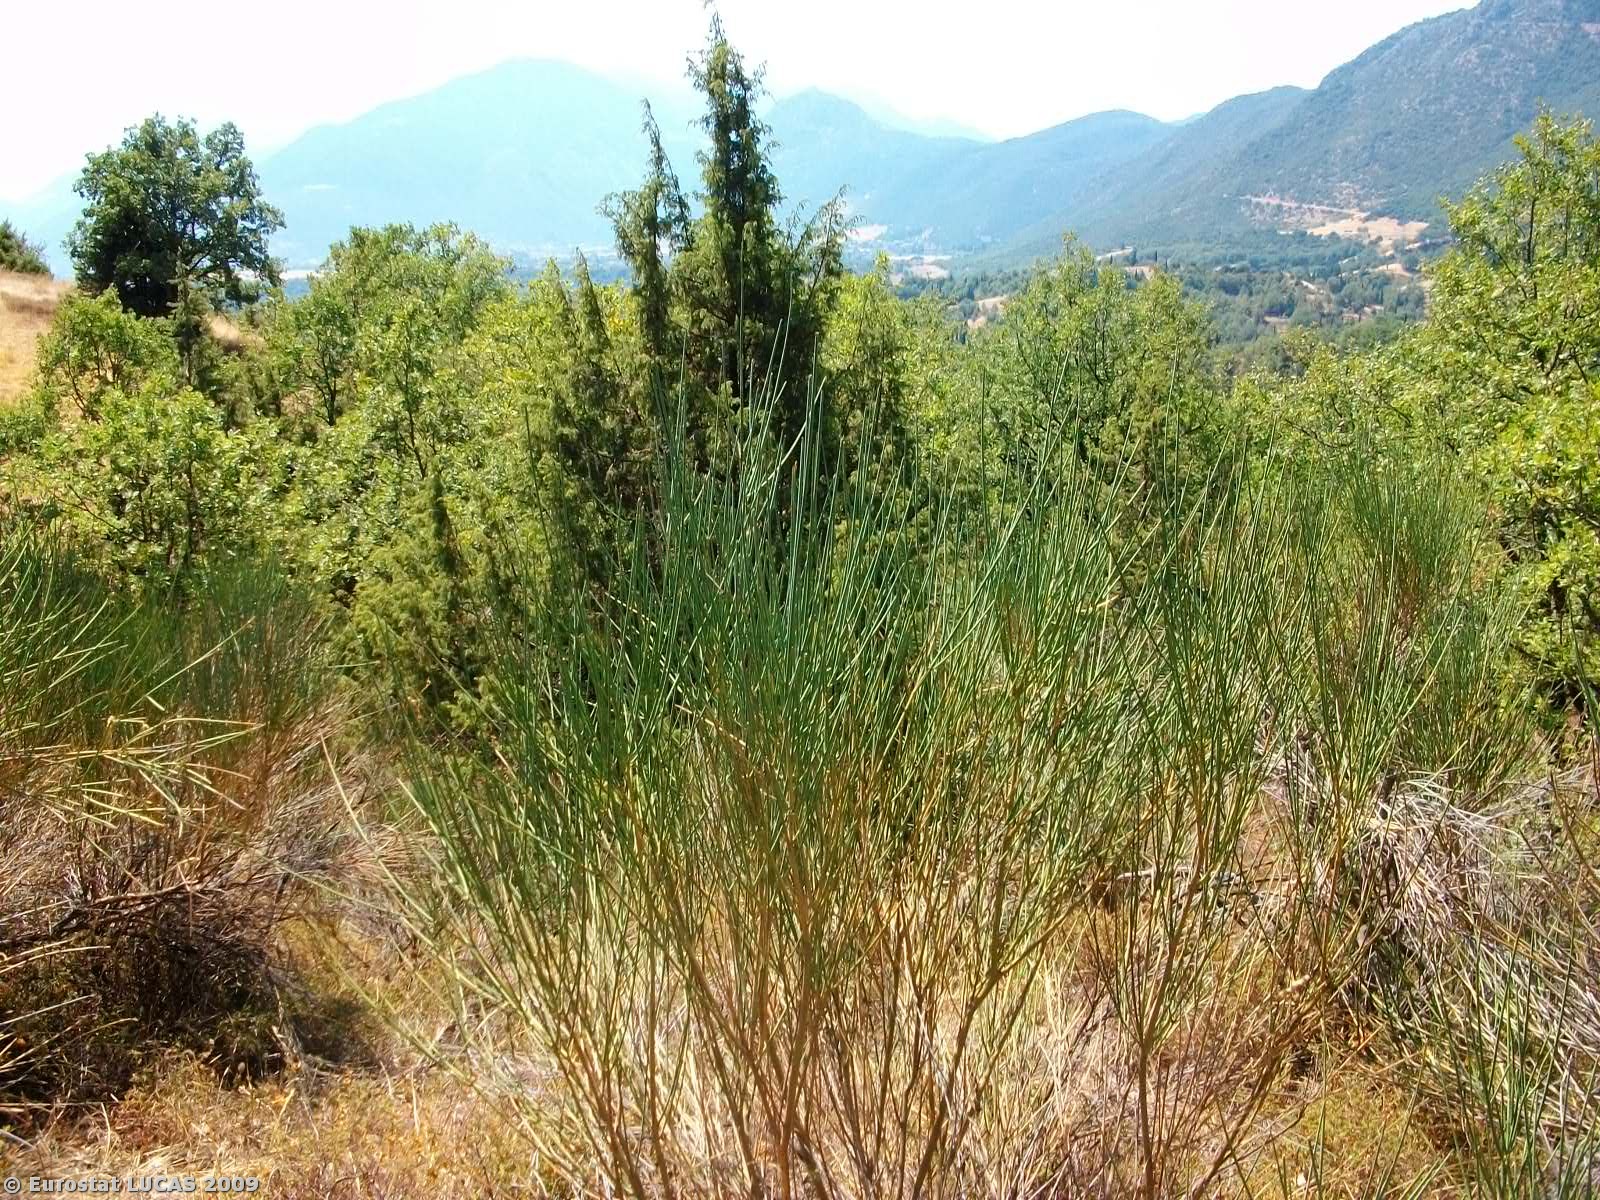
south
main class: Woodland
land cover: Mixed woodland
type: coniferous forest of the mediterranean region
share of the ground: 50 - 75 %
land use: Forestry
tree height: > 5 m
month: August
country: GR
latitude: 38.7258
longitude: 22.4124
